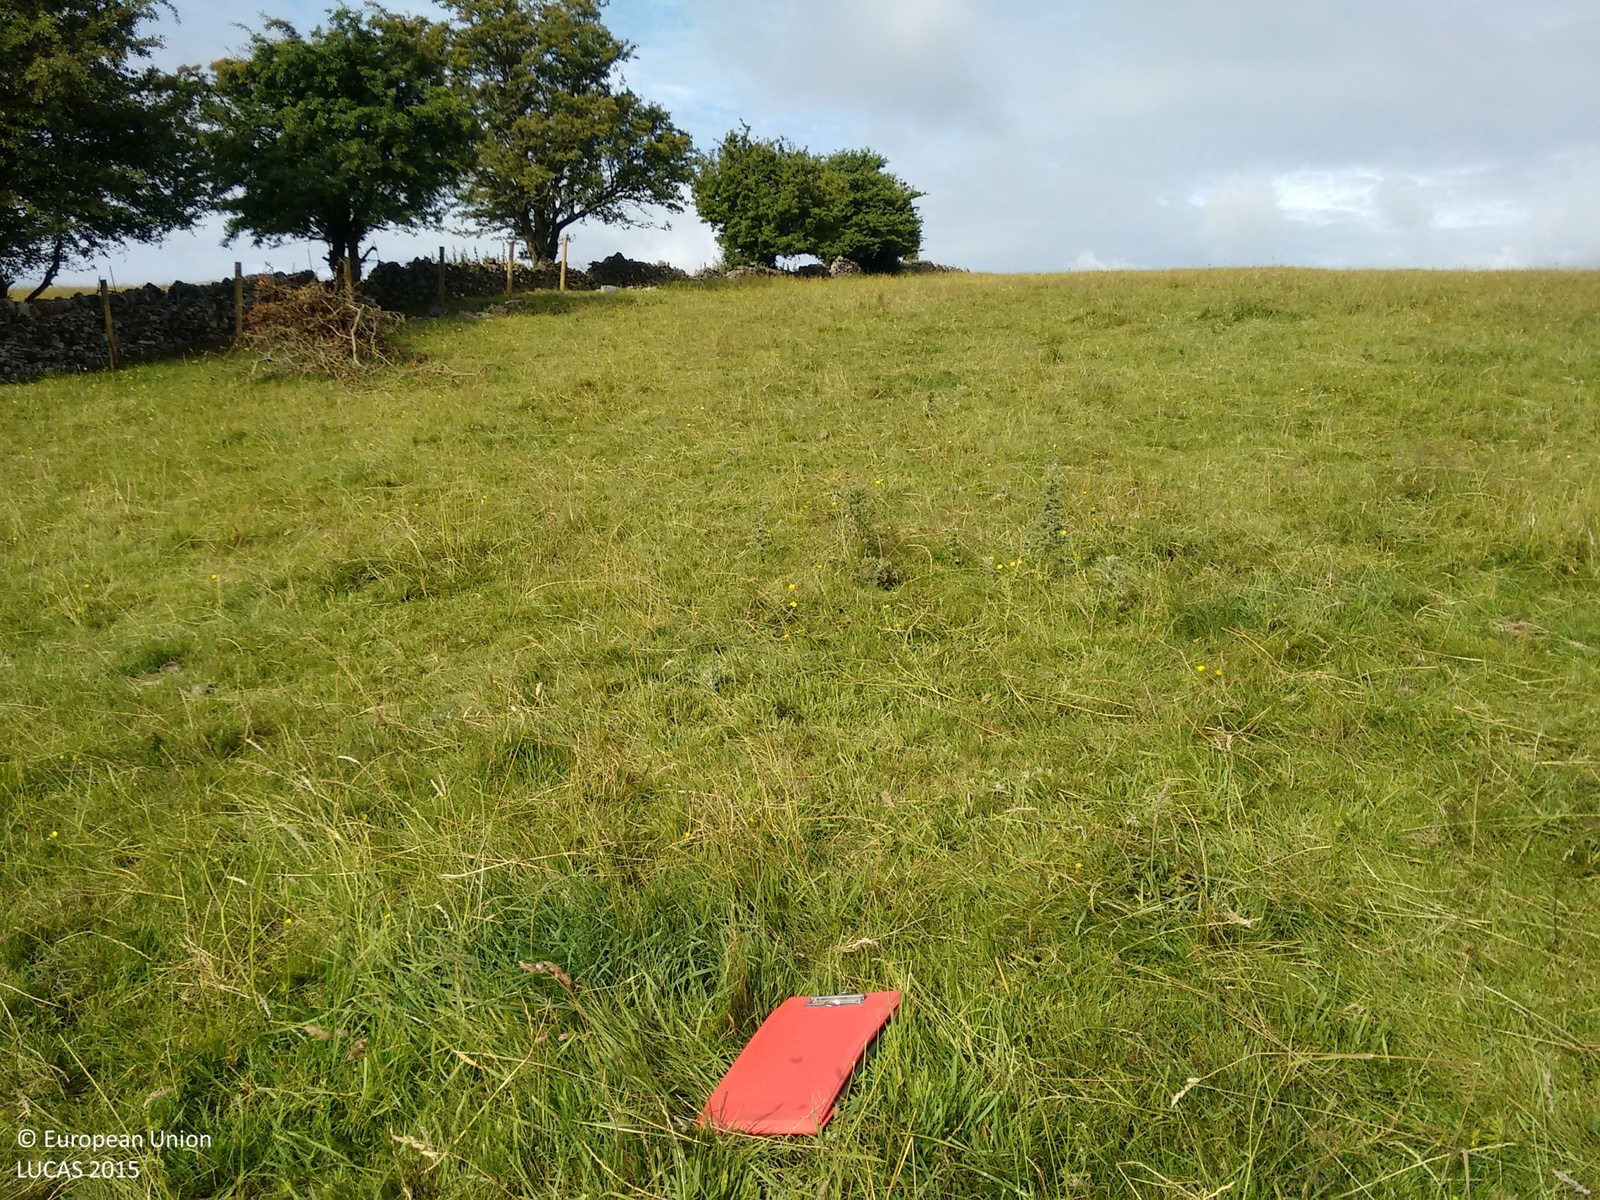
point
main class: Grassland
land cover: Grassland without tree/shrub cover
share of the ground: > 75 %
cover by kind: herbaceous plants 100 %
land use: Agriculture (excluding fallow land and kitchen gardens)
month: July
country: GB
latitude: 53.0793
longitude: -1.5911
